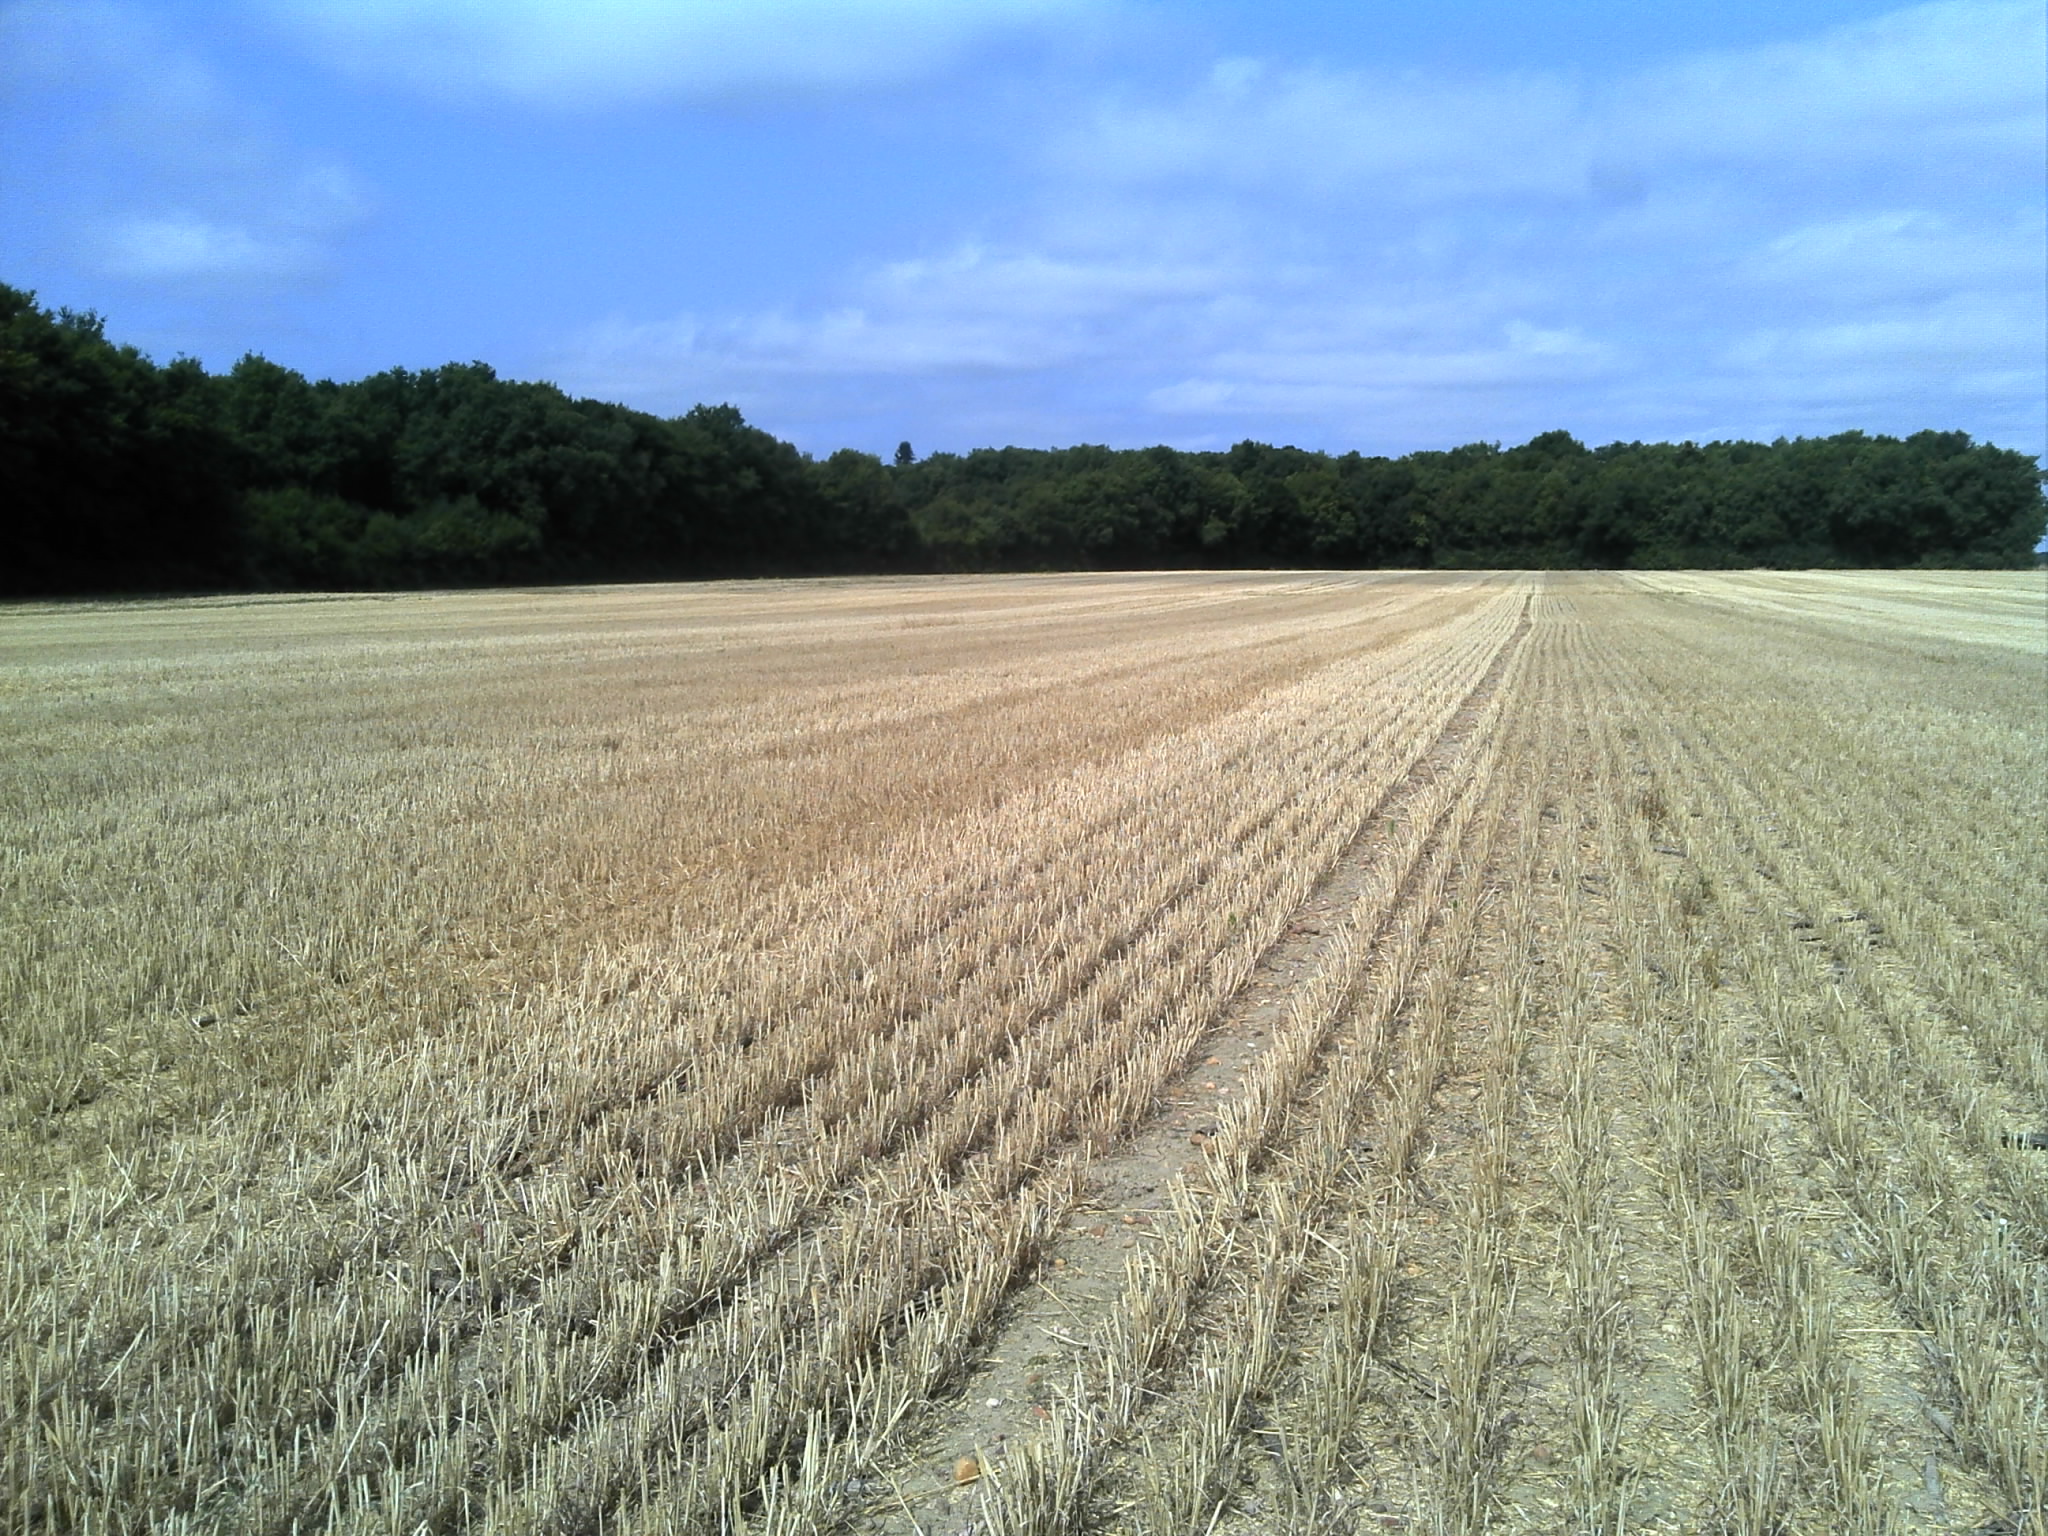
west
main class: Cropland
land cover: Durum wheat
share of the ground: 10 - 25 %
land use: Agriculture (excluding fallow land and kitchen gardens)
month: July
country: FR
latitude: 46.7940
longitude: 1.5387
